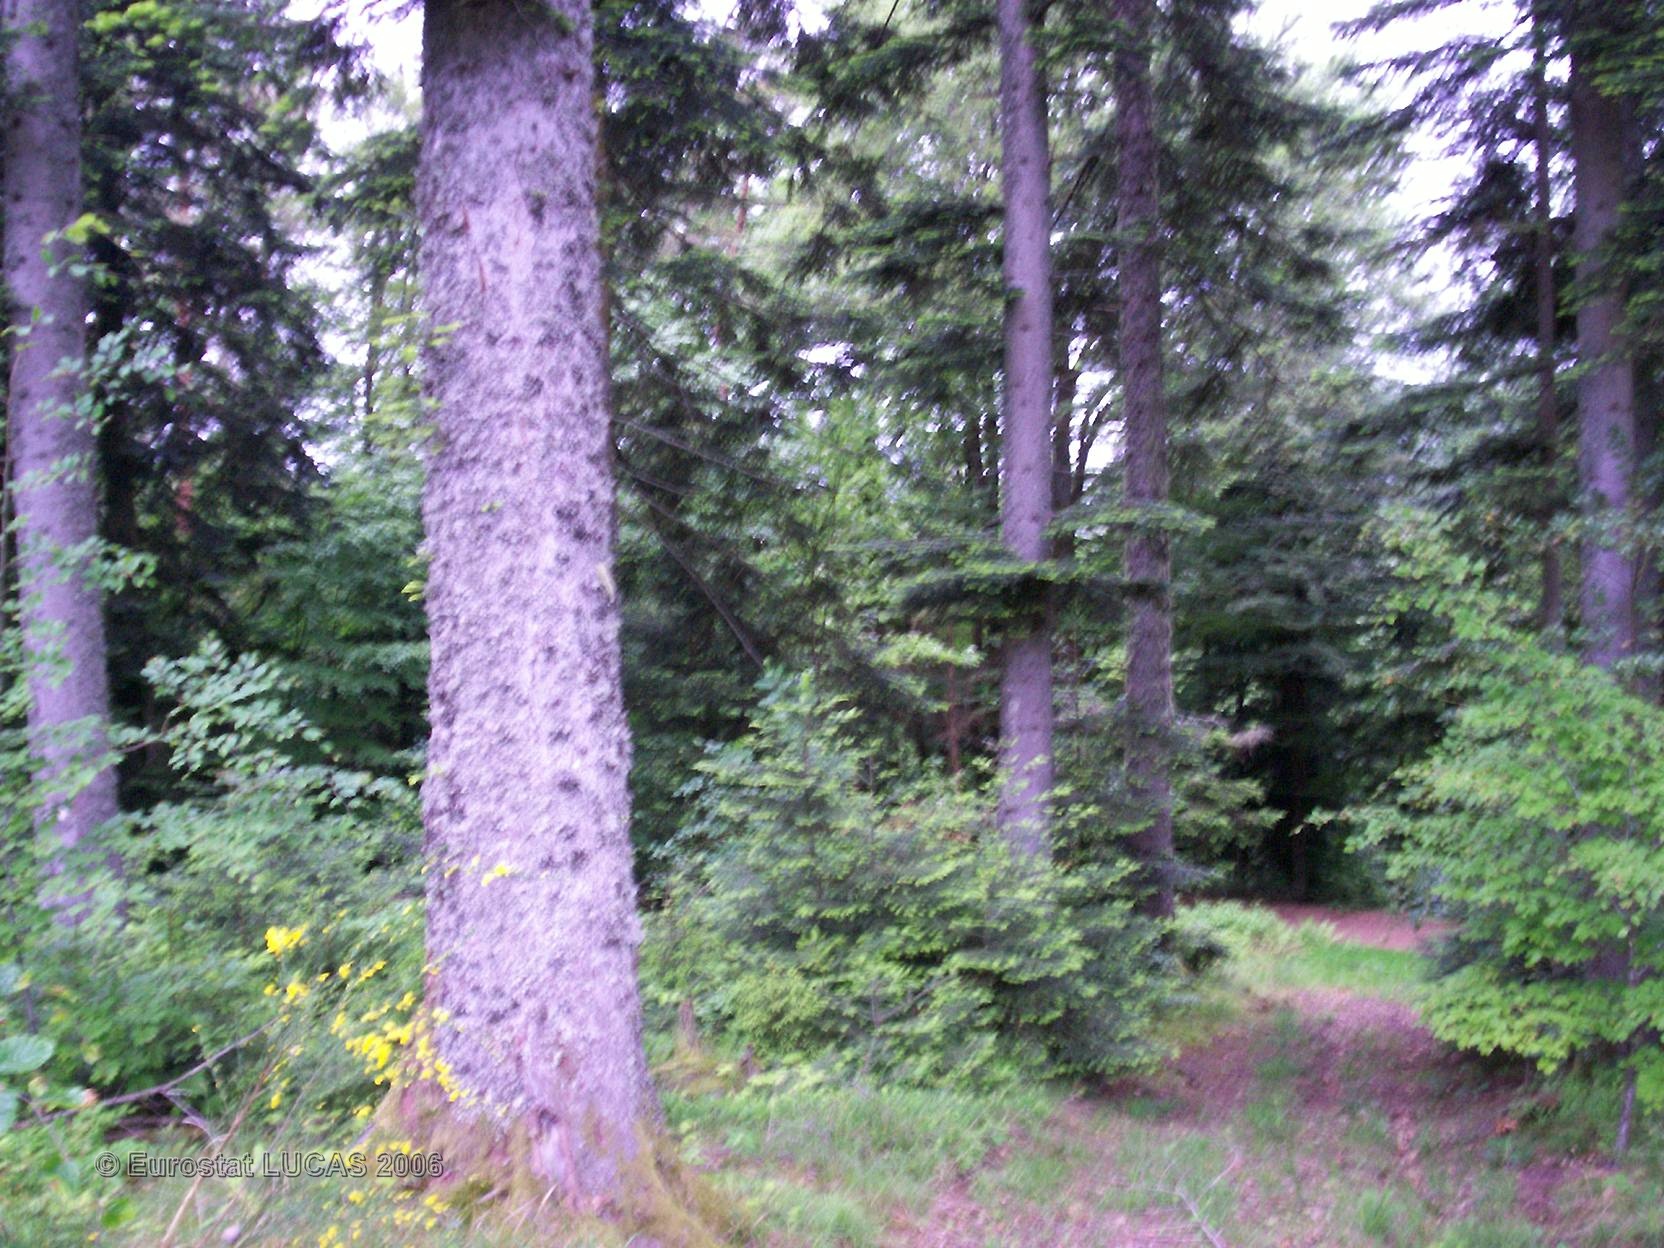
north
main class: Woodland
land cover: Mixed forest
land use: Forestry
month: May
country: FR
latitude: 48.1588
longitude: 6.7879
